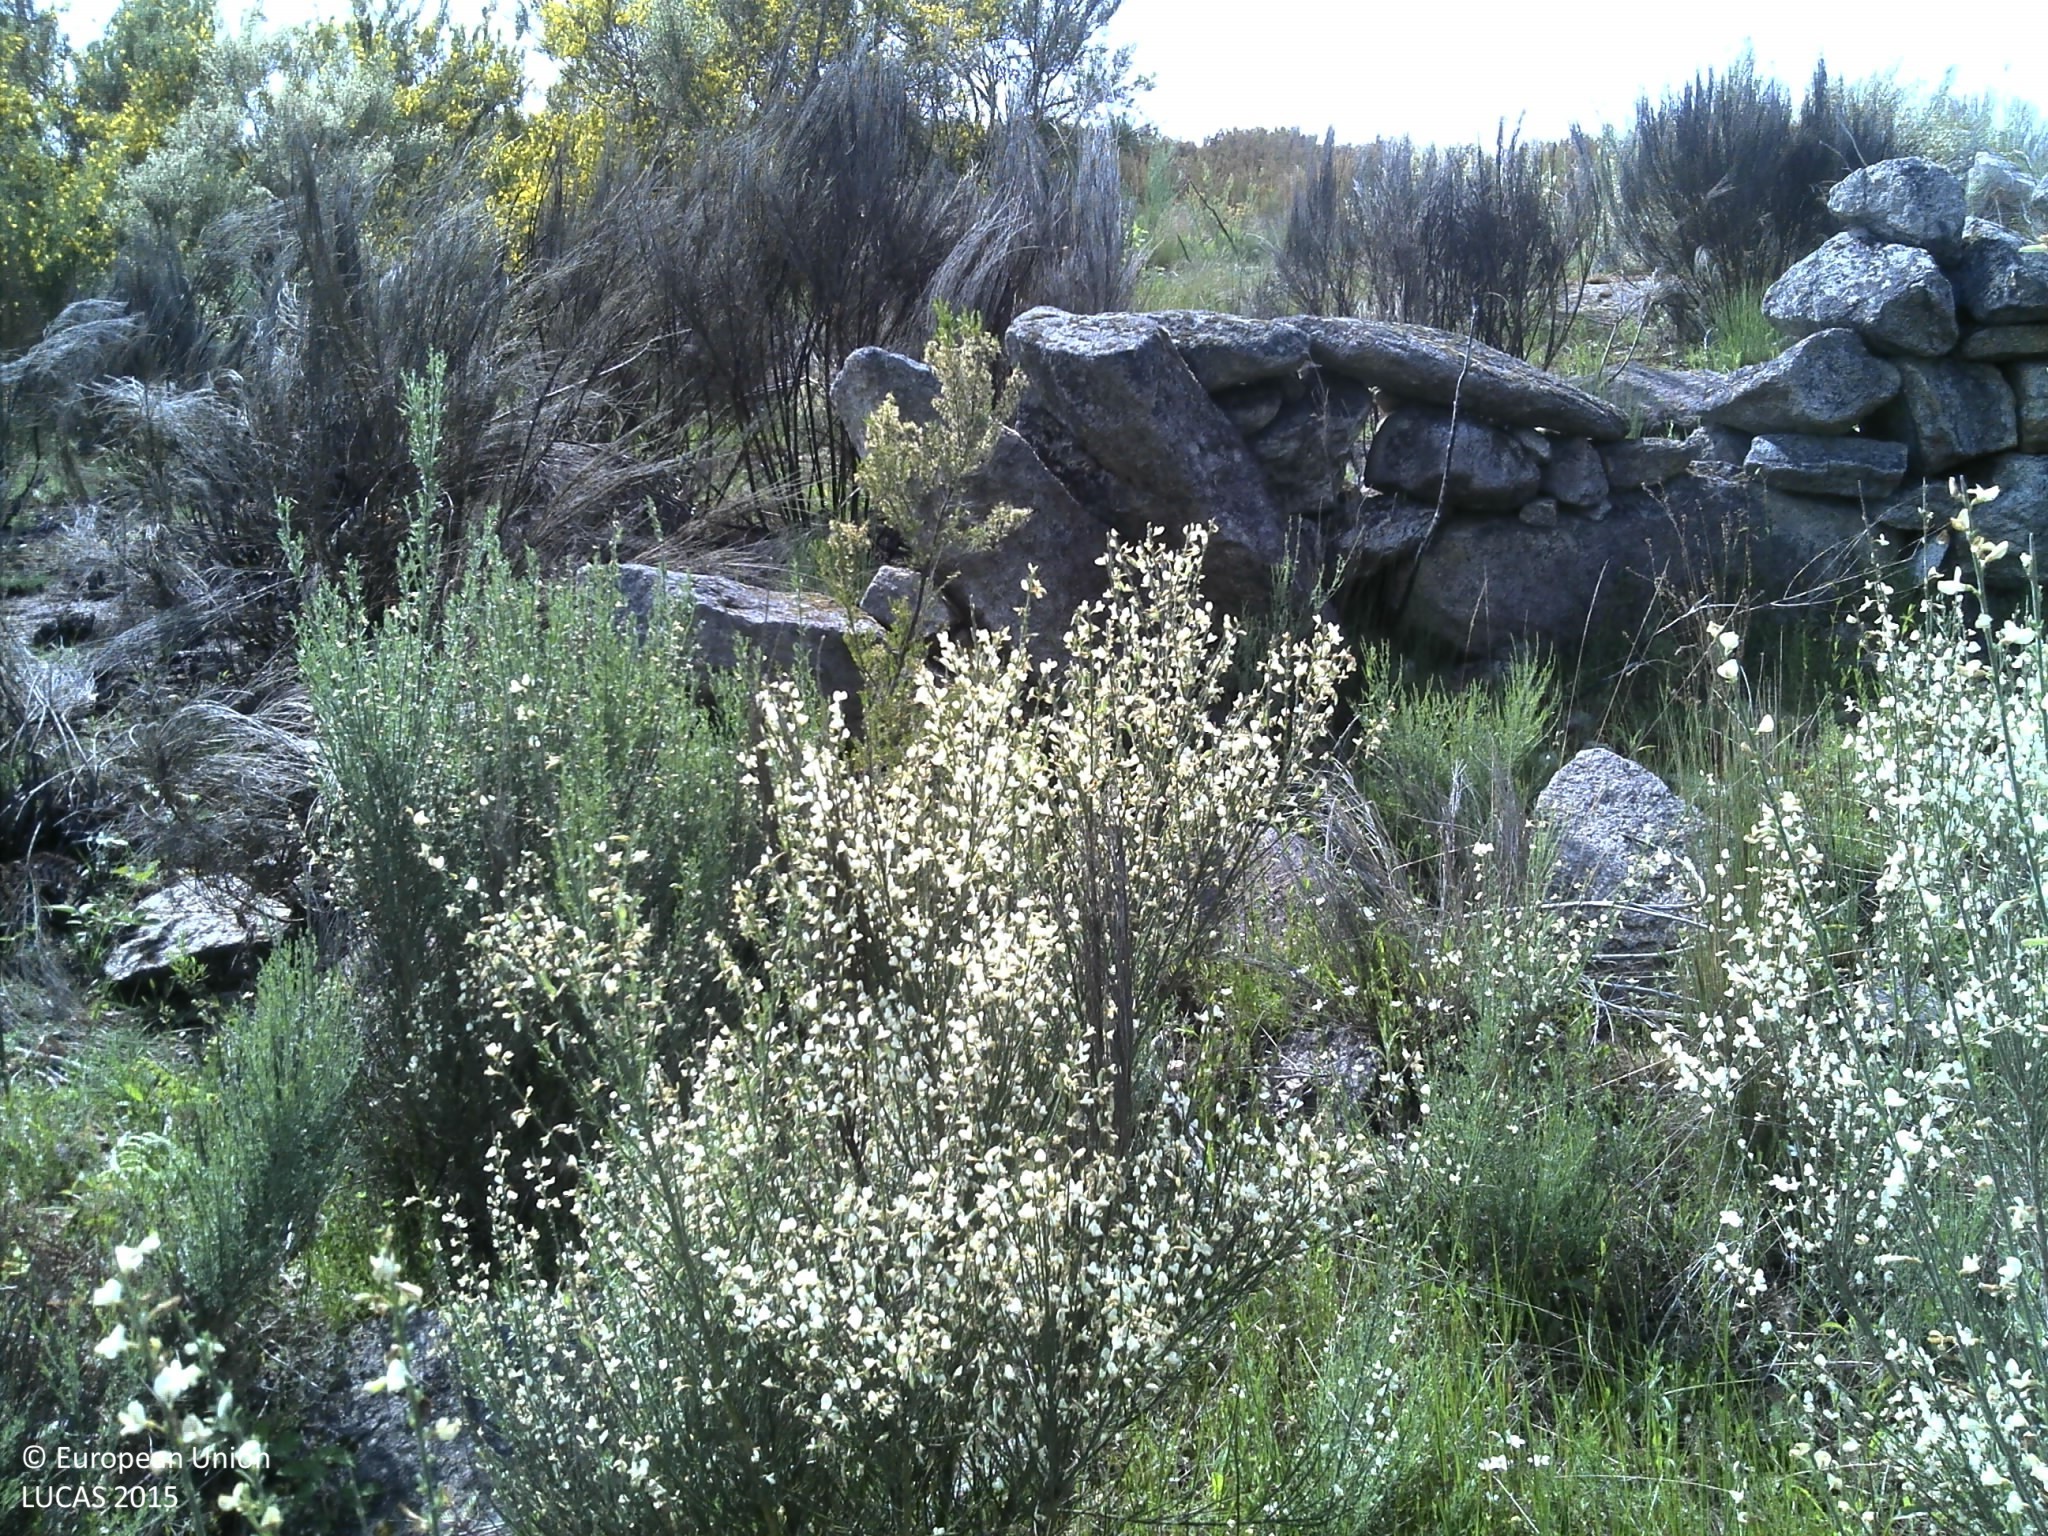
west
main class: Shrubland
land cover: Shrubland with sparse tree cover
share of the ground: 50 - 75 %
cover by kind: shrubs 70 %, unconsolidated bare surface 15 %, herbaceous plants 10 %, broadleaved forest trees 5 %
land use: Forestry
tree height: < 5 m
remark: Burnt area
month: May
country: PT
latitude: 41.9608
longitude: -7.0999
